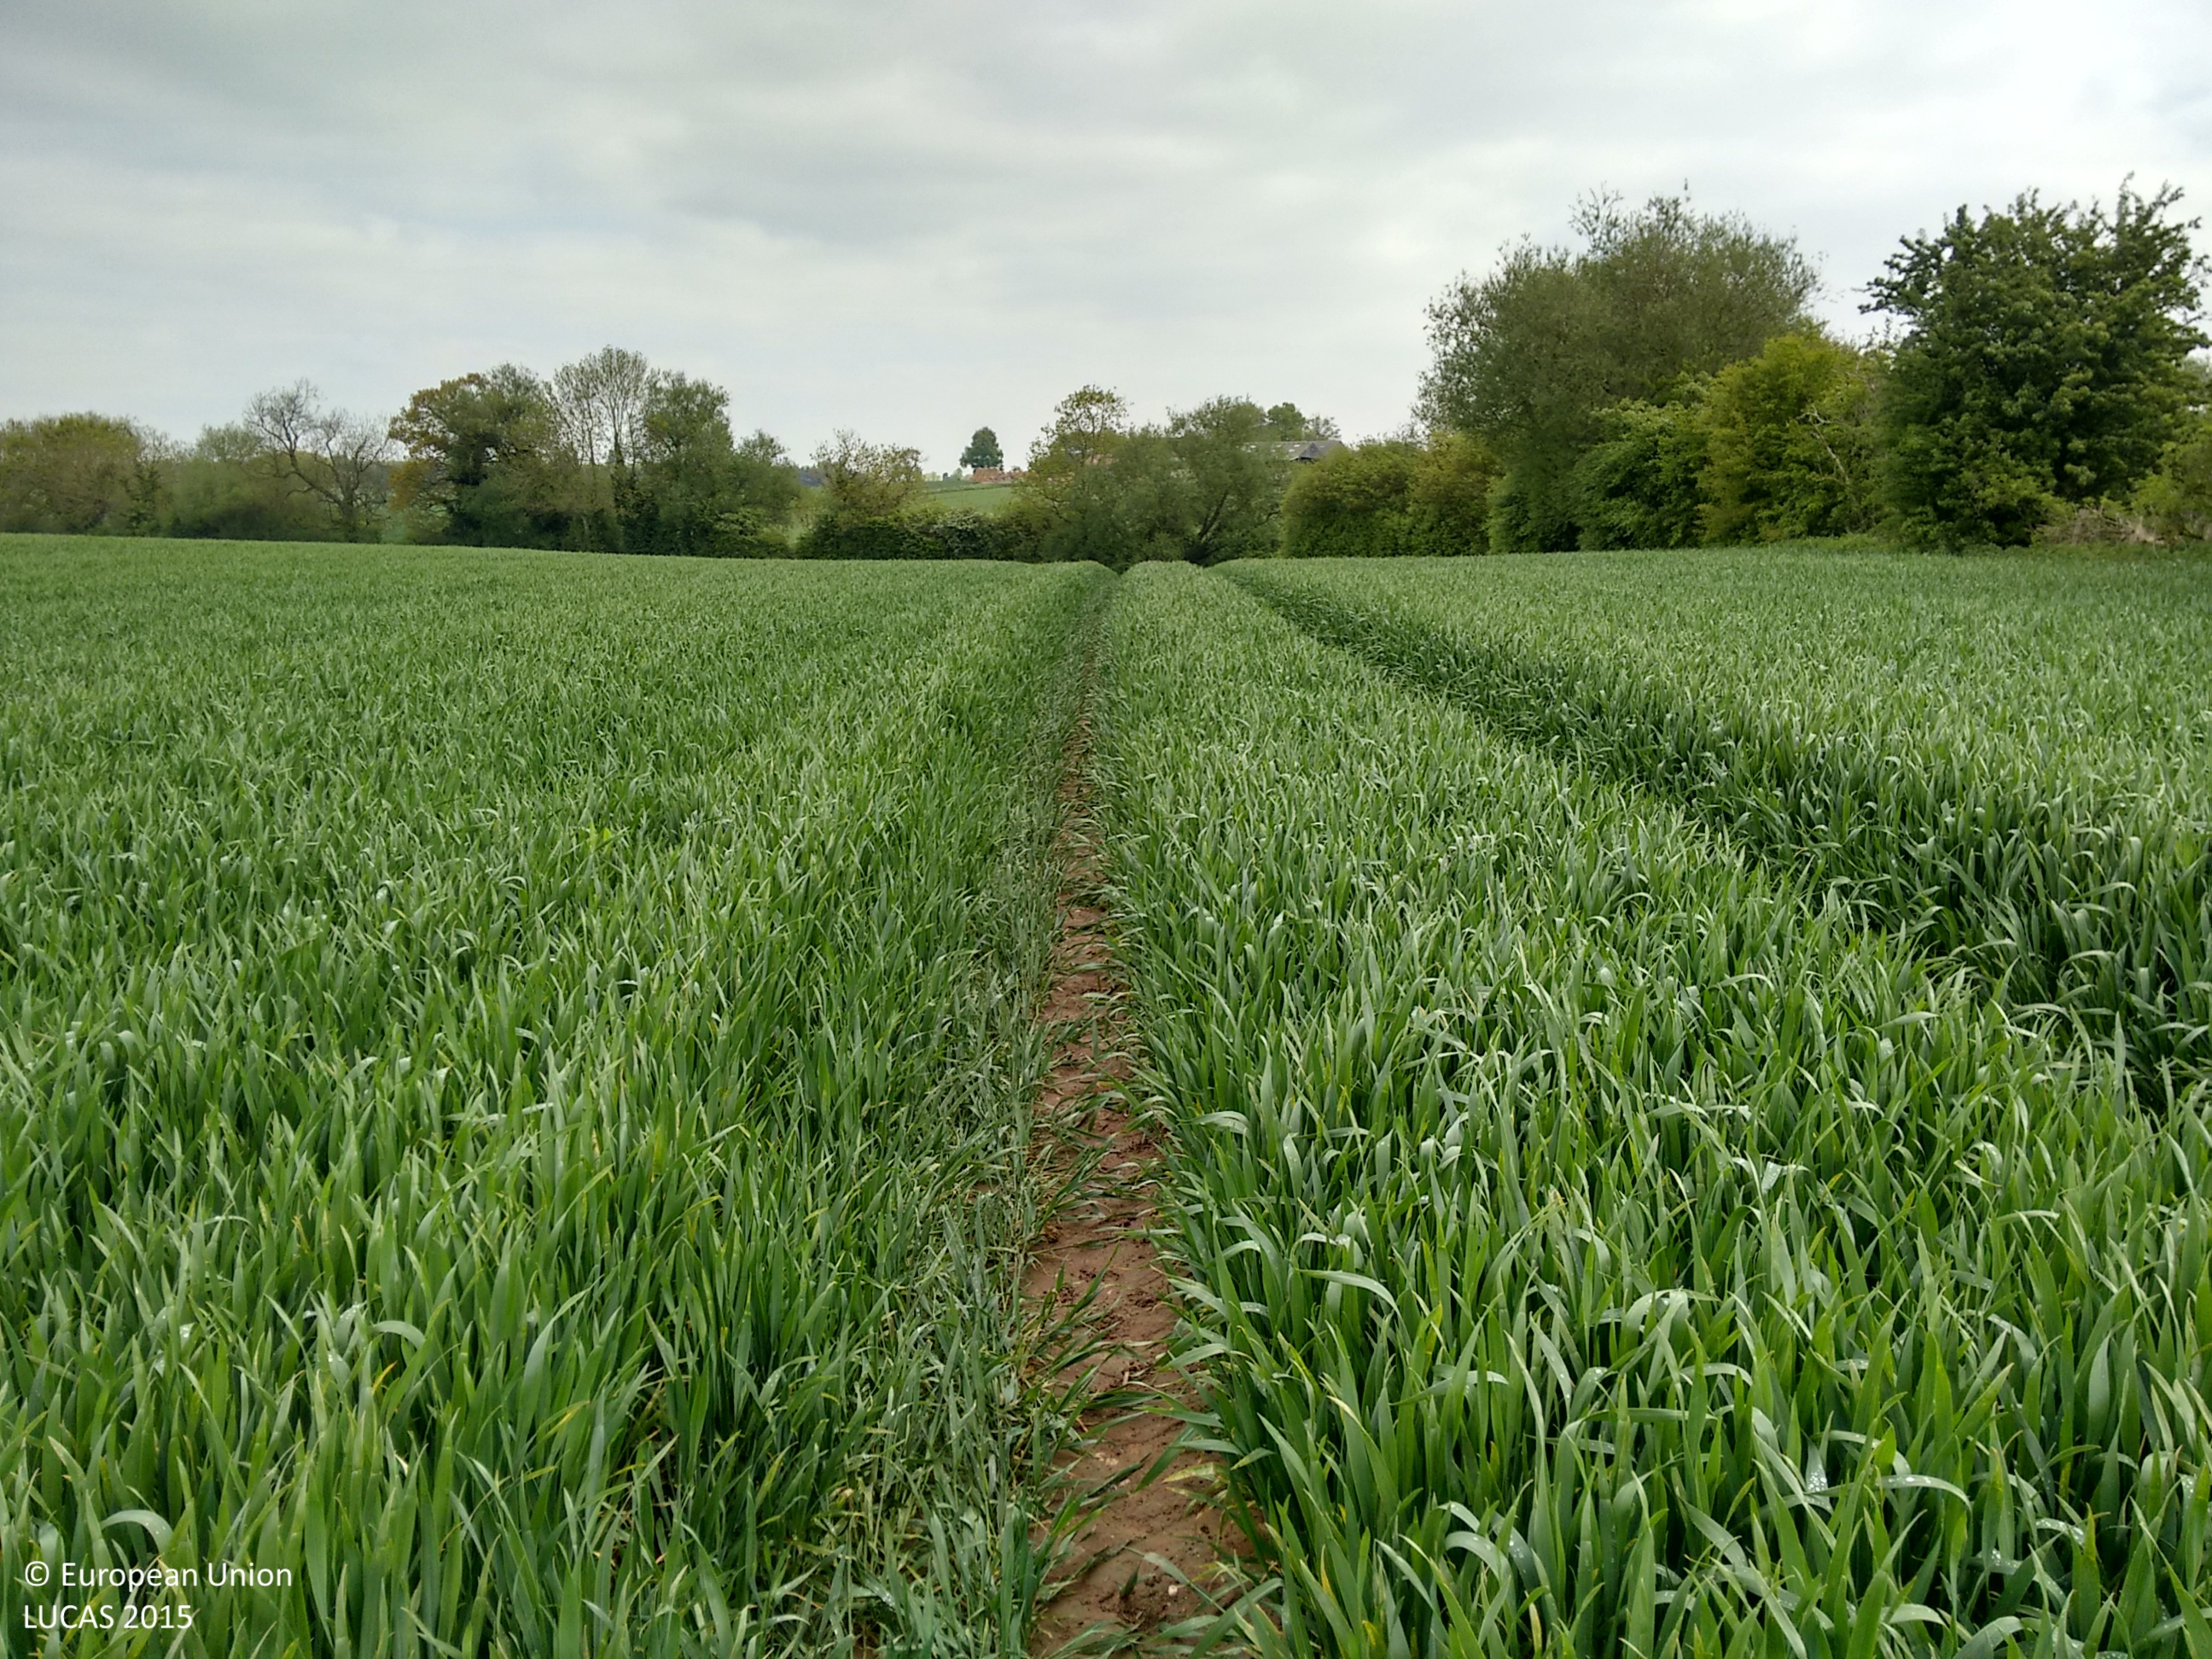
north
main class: Cropland
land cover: Common wheat
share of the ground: > 75 %
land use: Agriculture (excluding fallow land and kitchen gardens)
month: May
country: GB
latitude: 52.4352
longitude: -1.3007
